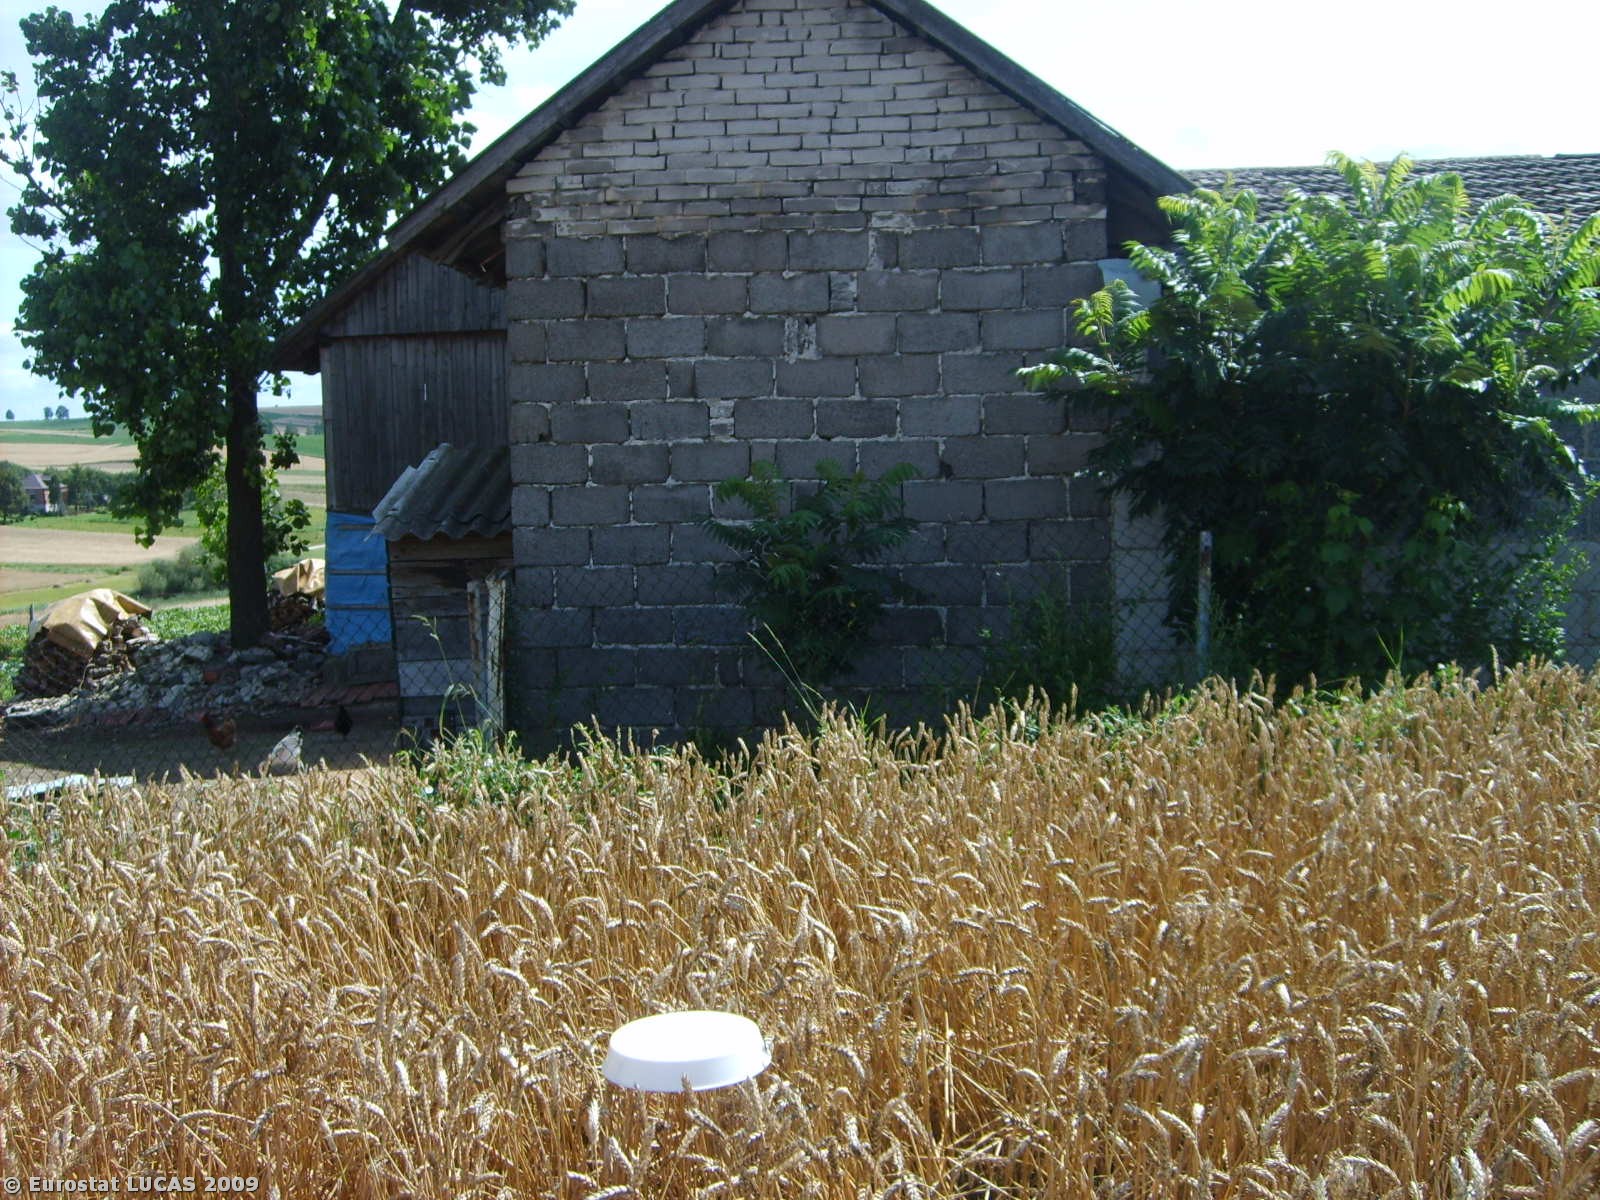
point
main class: Cropland
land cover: Common wheat
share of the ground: > 75 %
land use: Agriculture (excluding fallow land and kitchen gardens)
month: July
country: PL
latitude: 50.3172
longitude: 20.2734
